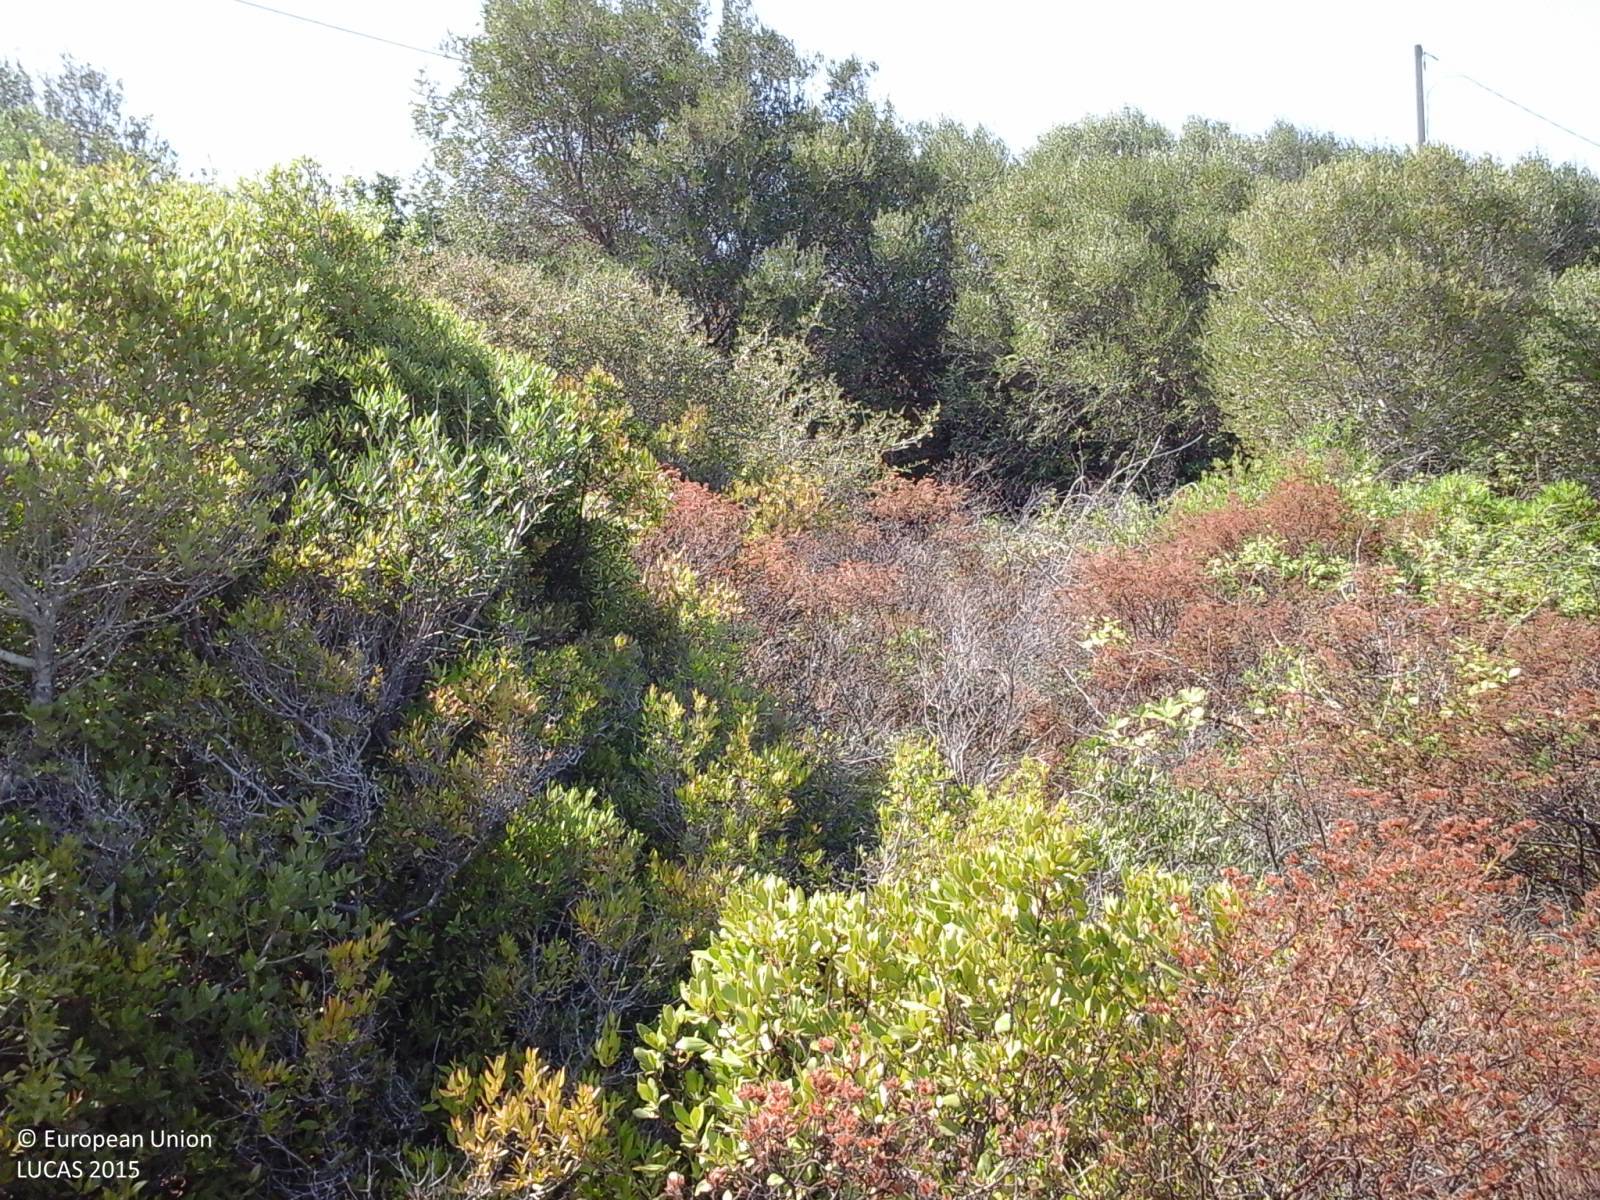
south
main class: Shrubland
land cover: Shrubland without tree cover
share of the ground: > 75 %
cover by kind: shrubs 70 %, herbaceous plants 30 %
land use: Semi-natural and natural areas not in use
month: July
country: IT
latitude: 41.1694
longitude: 9.2762
